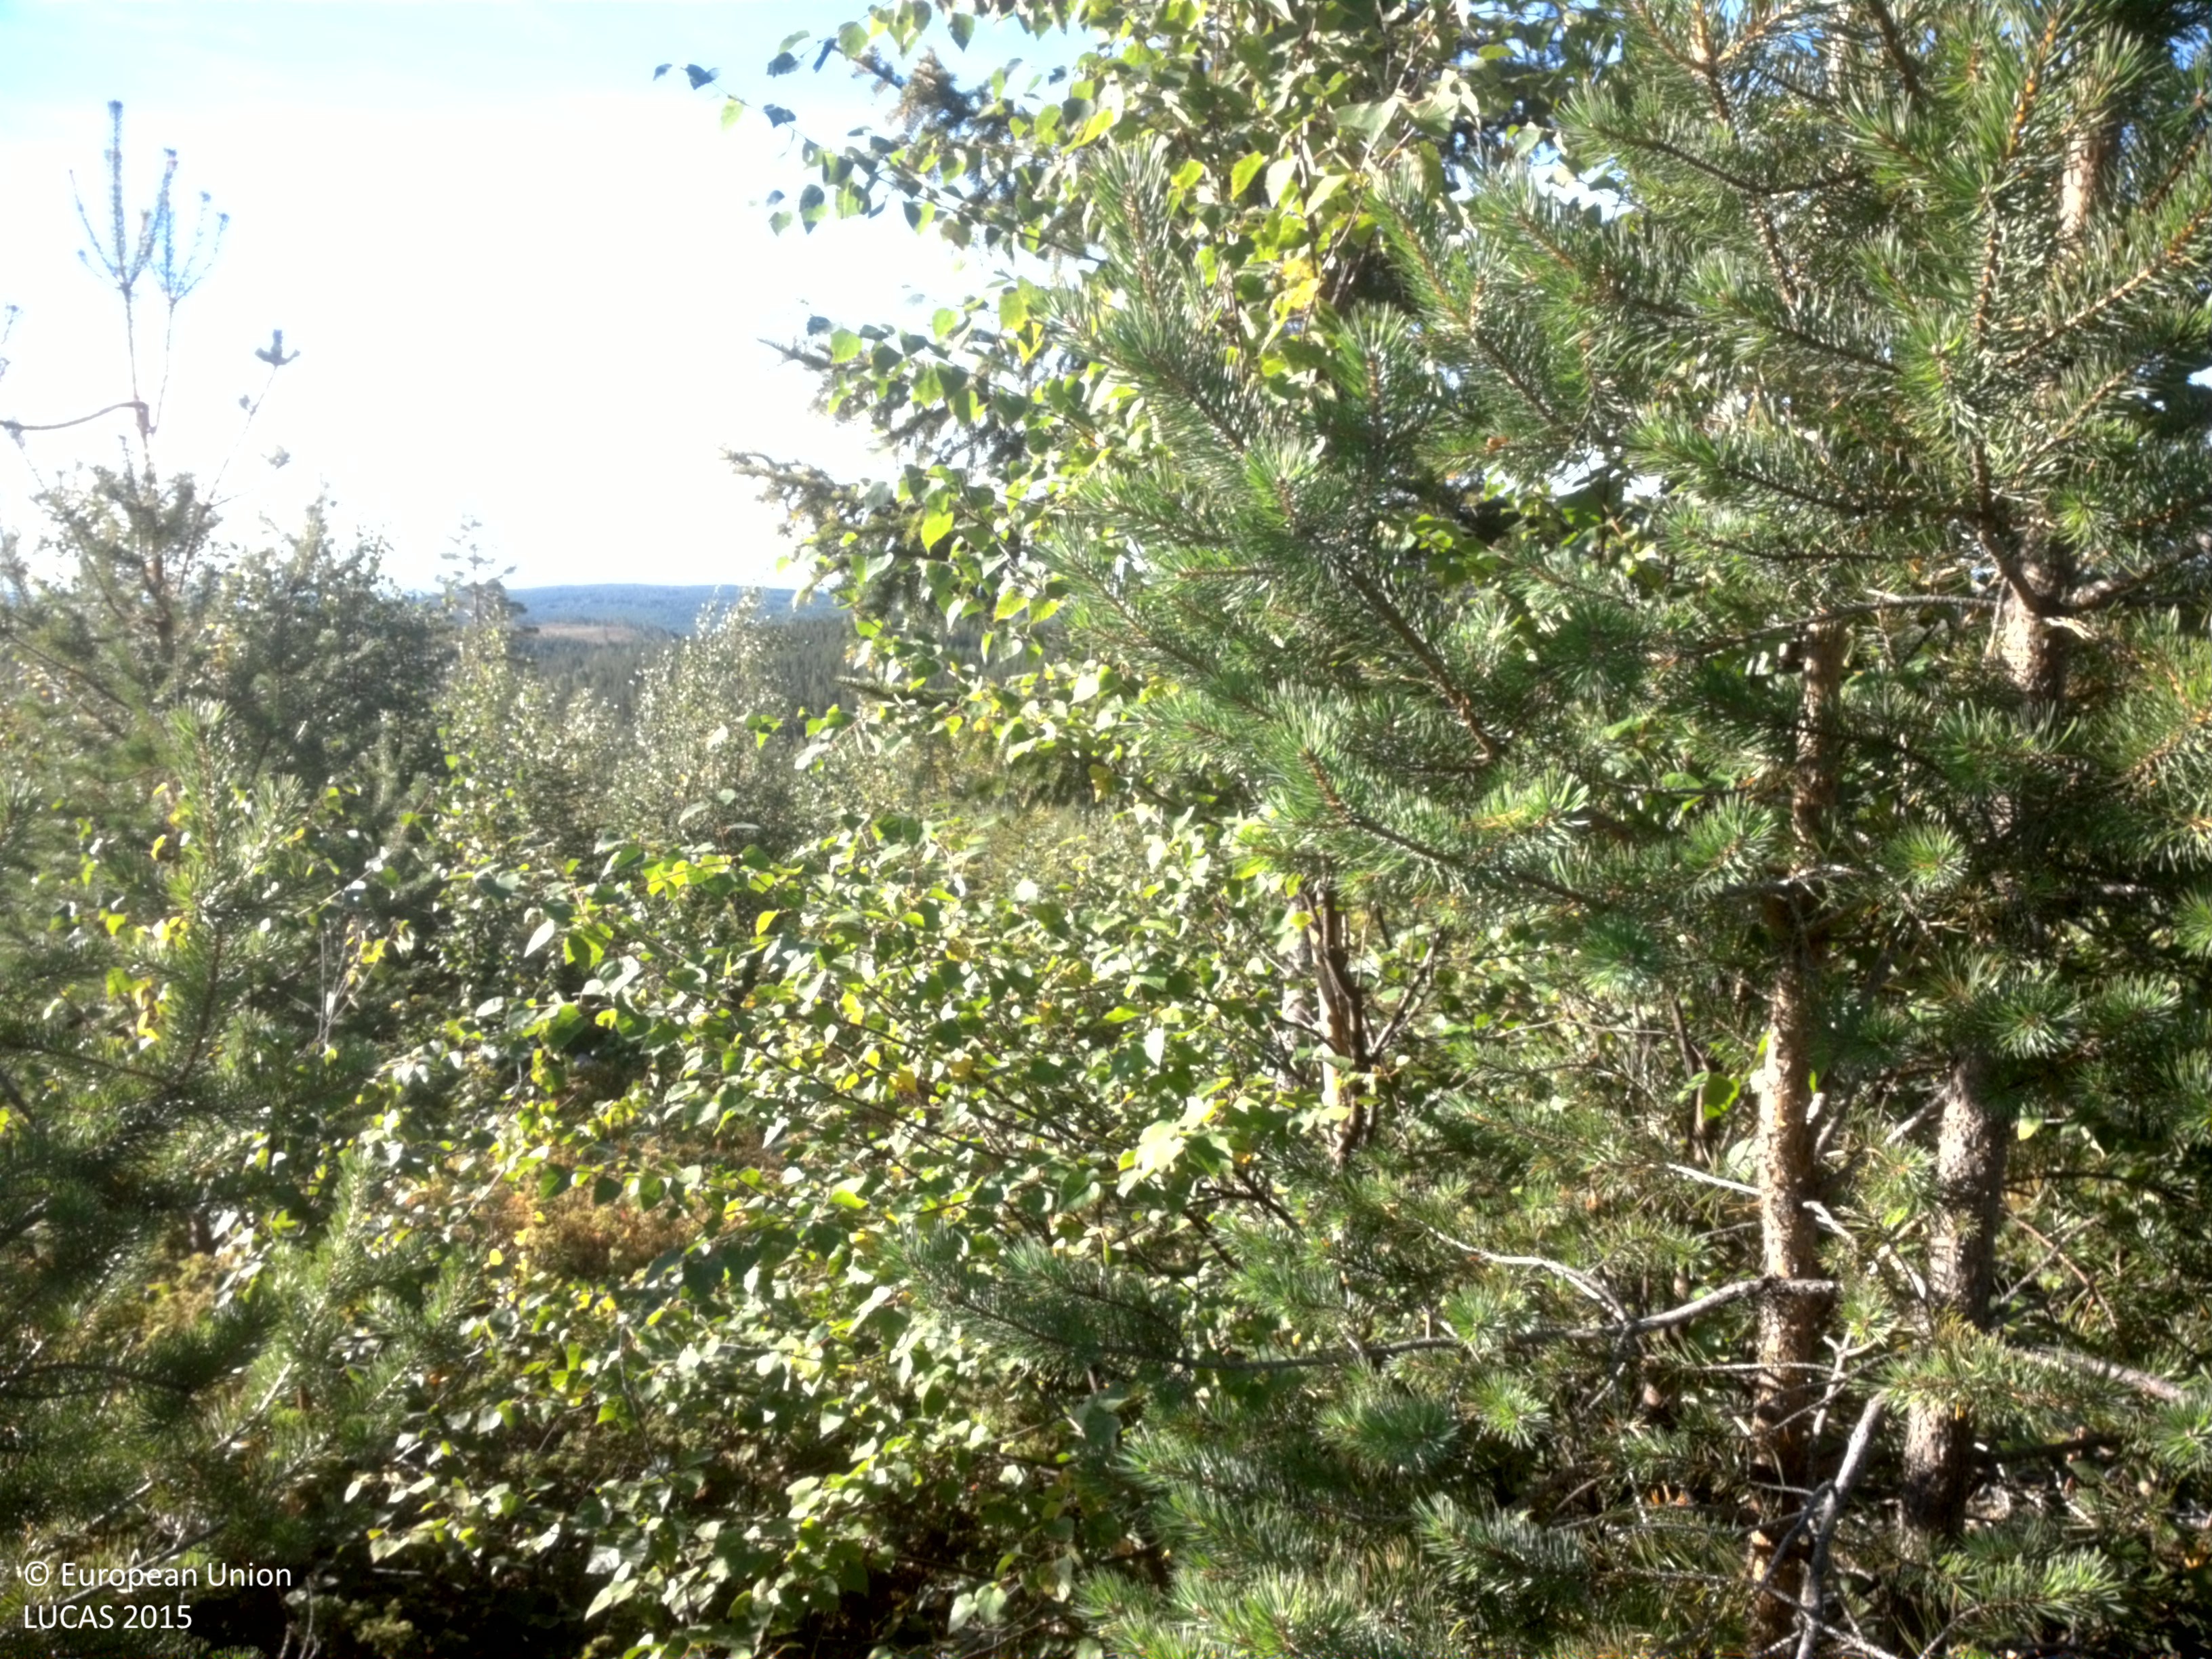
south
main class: Woodland
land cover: Other mixed woodland
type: boreal forest
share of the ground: > 75 %
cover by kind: coniferous forest trees 45 %, broadleaved forest trees 35 %, shrubs 10 %, herbaceous plants 5 %, lichens and mosses 5 %
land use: Forestry
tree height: < 5 m
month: September
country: SE
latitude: 64.5917
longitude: 19.0975
